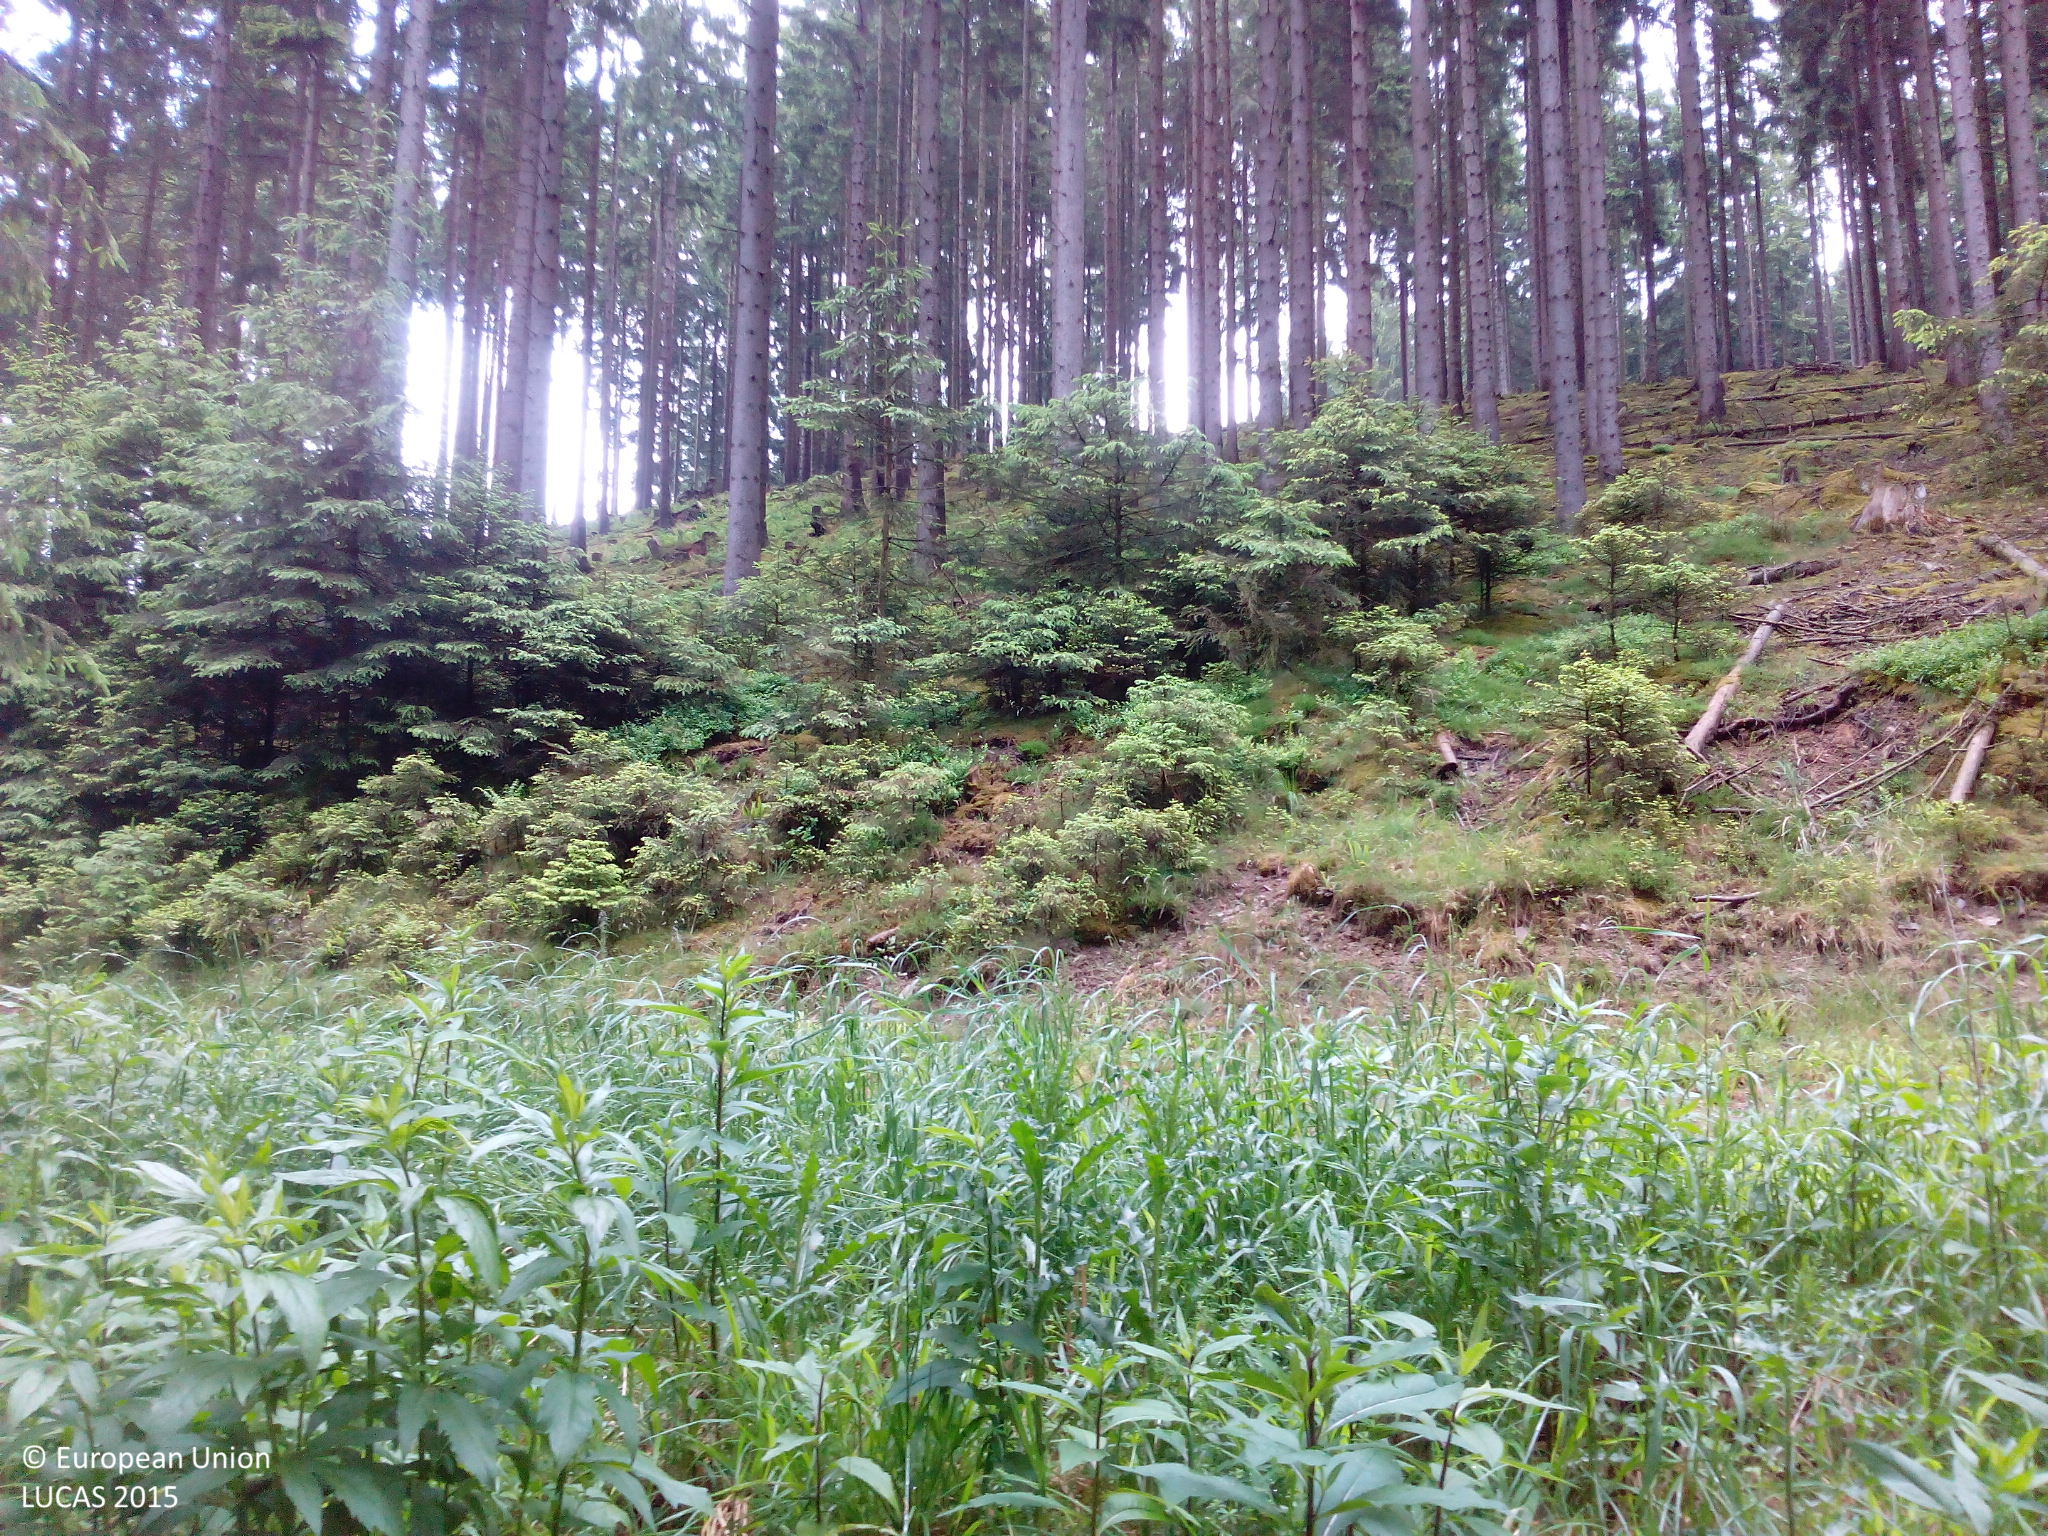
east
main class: Woodland
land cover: Spruce dominated coniferous woodland
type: hemiboreal forest and nemoral coniferous forest and mixed broadleaved-coniferous forest
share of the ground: > 75 %
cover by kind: coniferous forest trees 95 %, broadleaved forest trees 5 %
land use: Forestry
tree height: > 5 m
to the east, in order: Spruce dominated coniferous woodland; Grassland without tree/shrub cover; Tracks; Shrubland with sparse tree cover; Spruce dominated coniferous woodland; Rivers and streams; Grassland without tree/shrub cover; Spruce dominated coniferous woodland
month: June
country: DE
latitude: 51.4700
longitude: 8.5752
